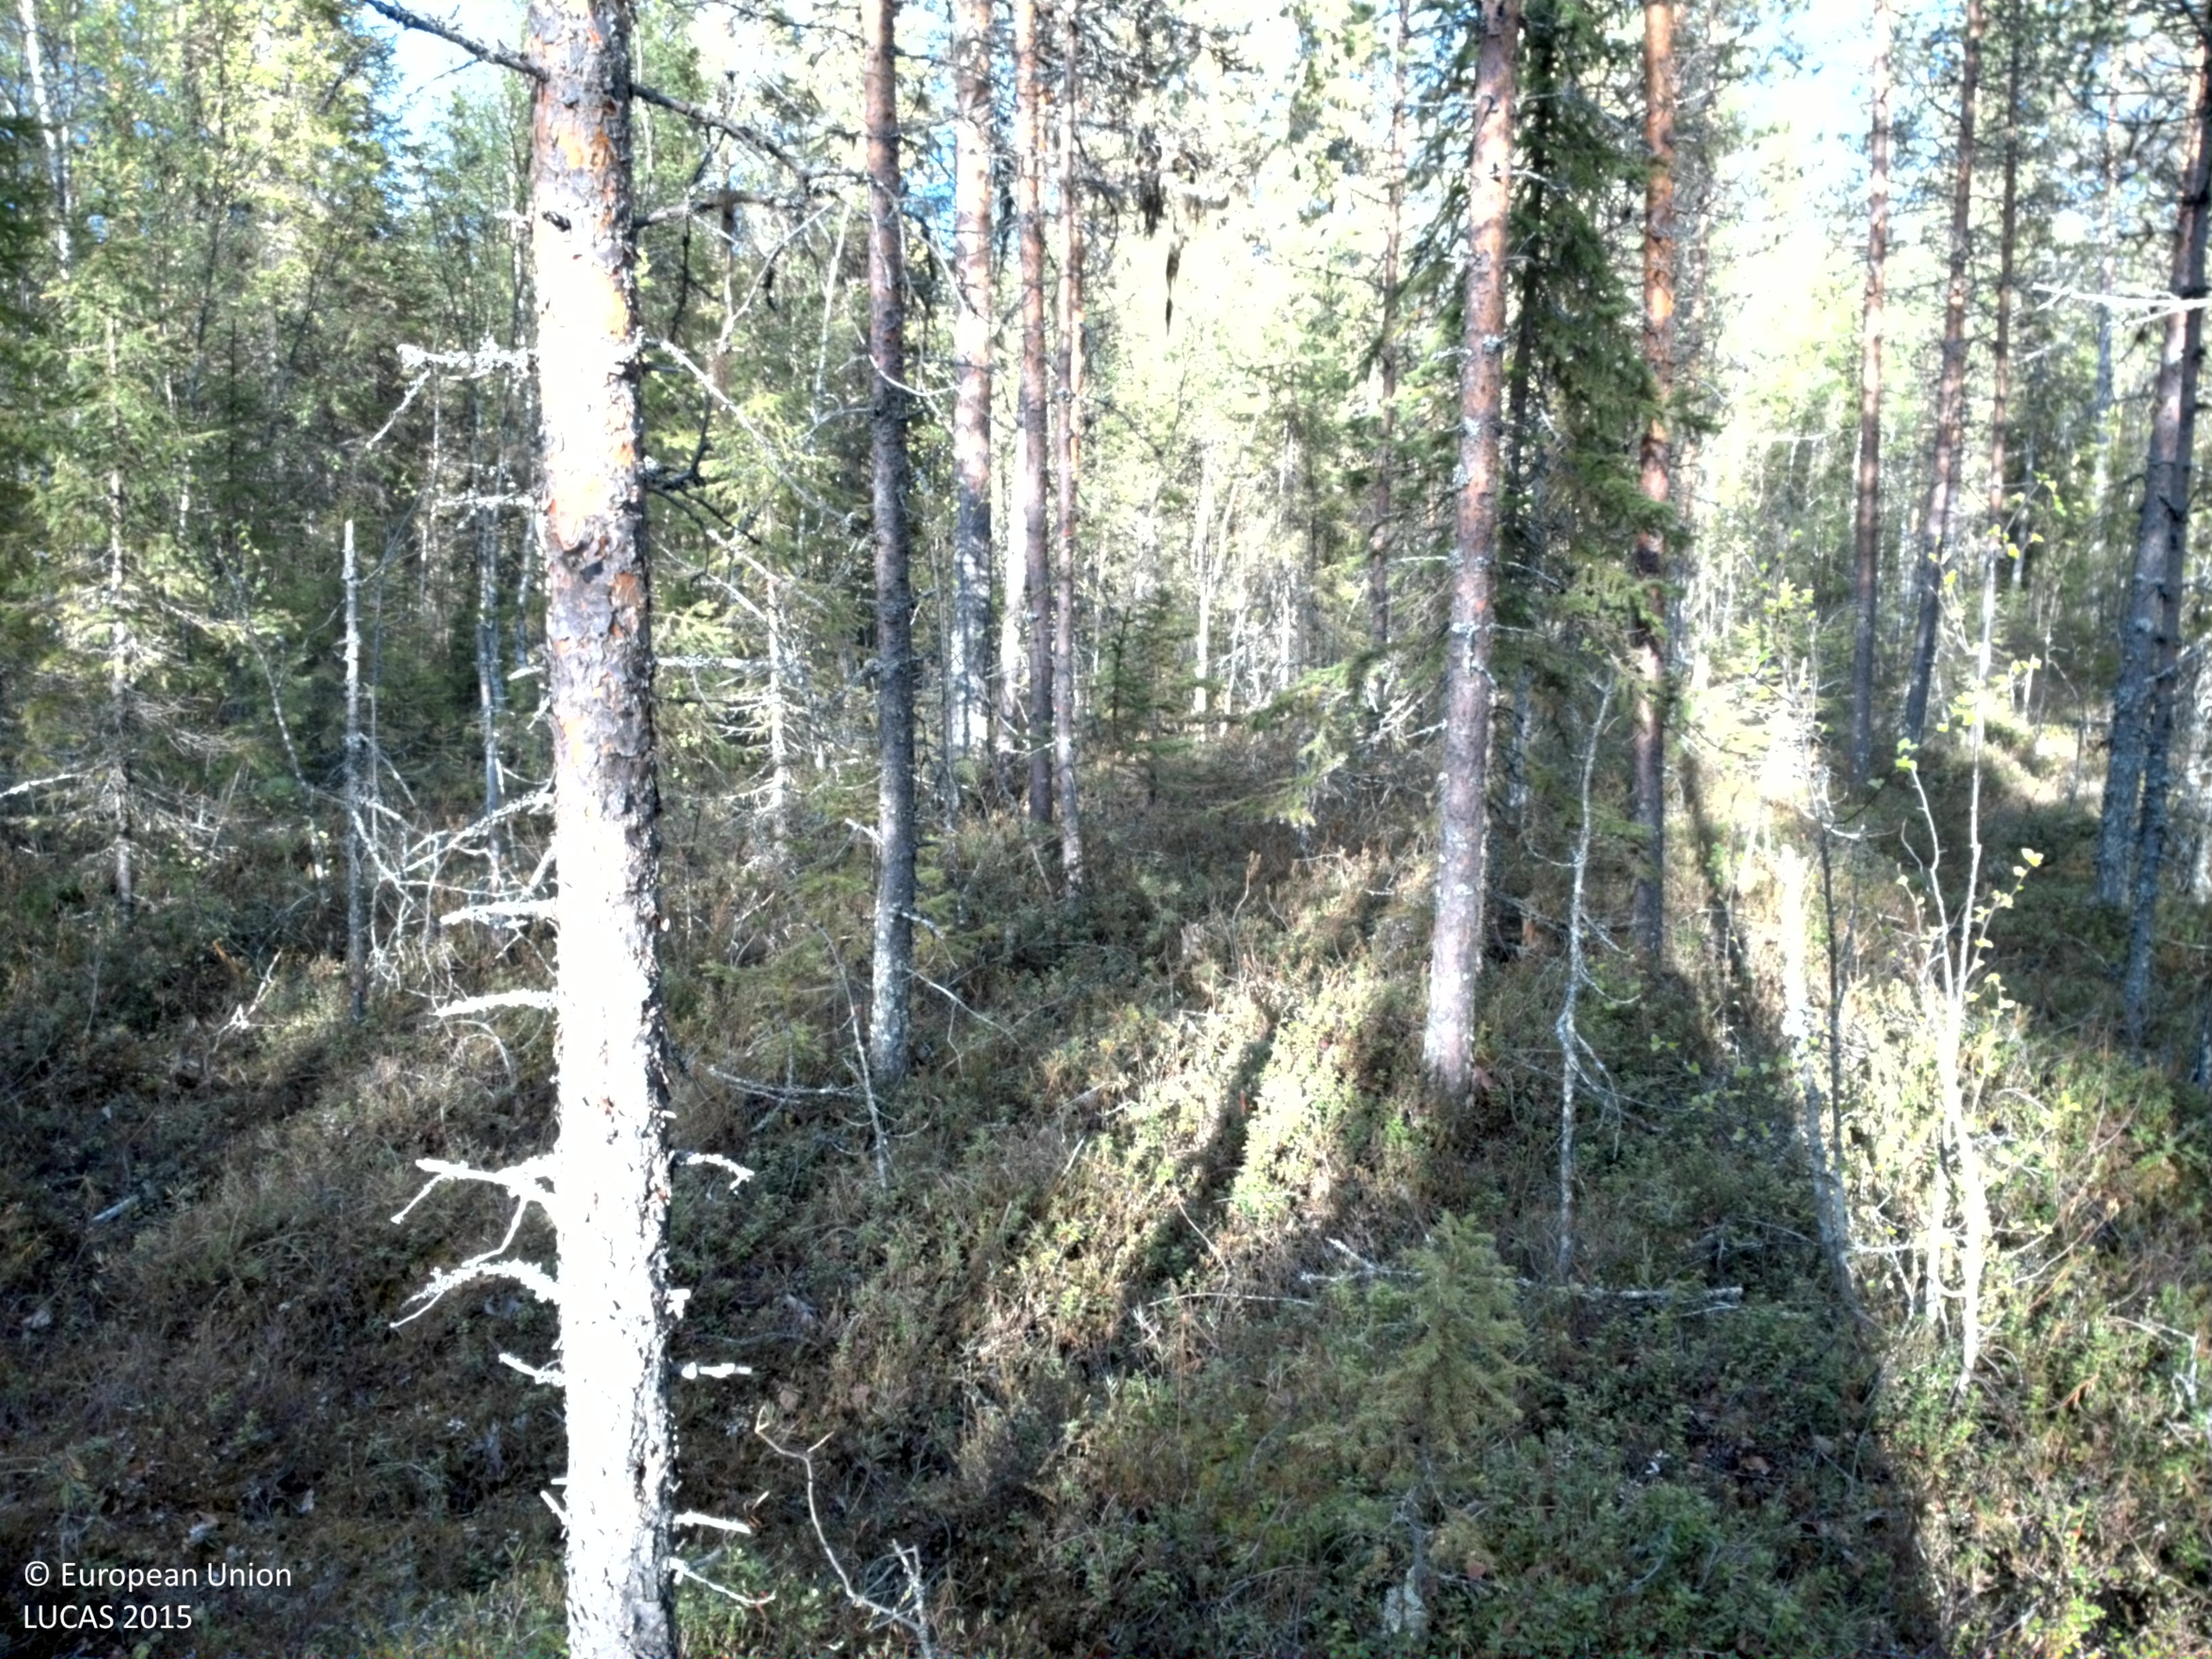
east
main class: Woodland
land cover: Pine dominated coniferous woodland
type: boreal forest
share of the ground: 50 - 75 %
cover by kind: coniferous forest trees 55 %, shrubs 40 %, broadleaved forest trees 5 %
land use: Forestry
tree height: > 5 m
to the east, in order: Pine dominated coniferous woodland; Pine dominated mixed woodland; Inland fresh running water; Shrubland with sparse tree cover; Spruce dominated mixed woodland; Spruce dominated coniferous woodland; Pine dominated coniferous woodland; Tracks; Pine dominated coniferous woodland
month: June
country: SE
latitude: 66.4757
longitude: 22.9318
